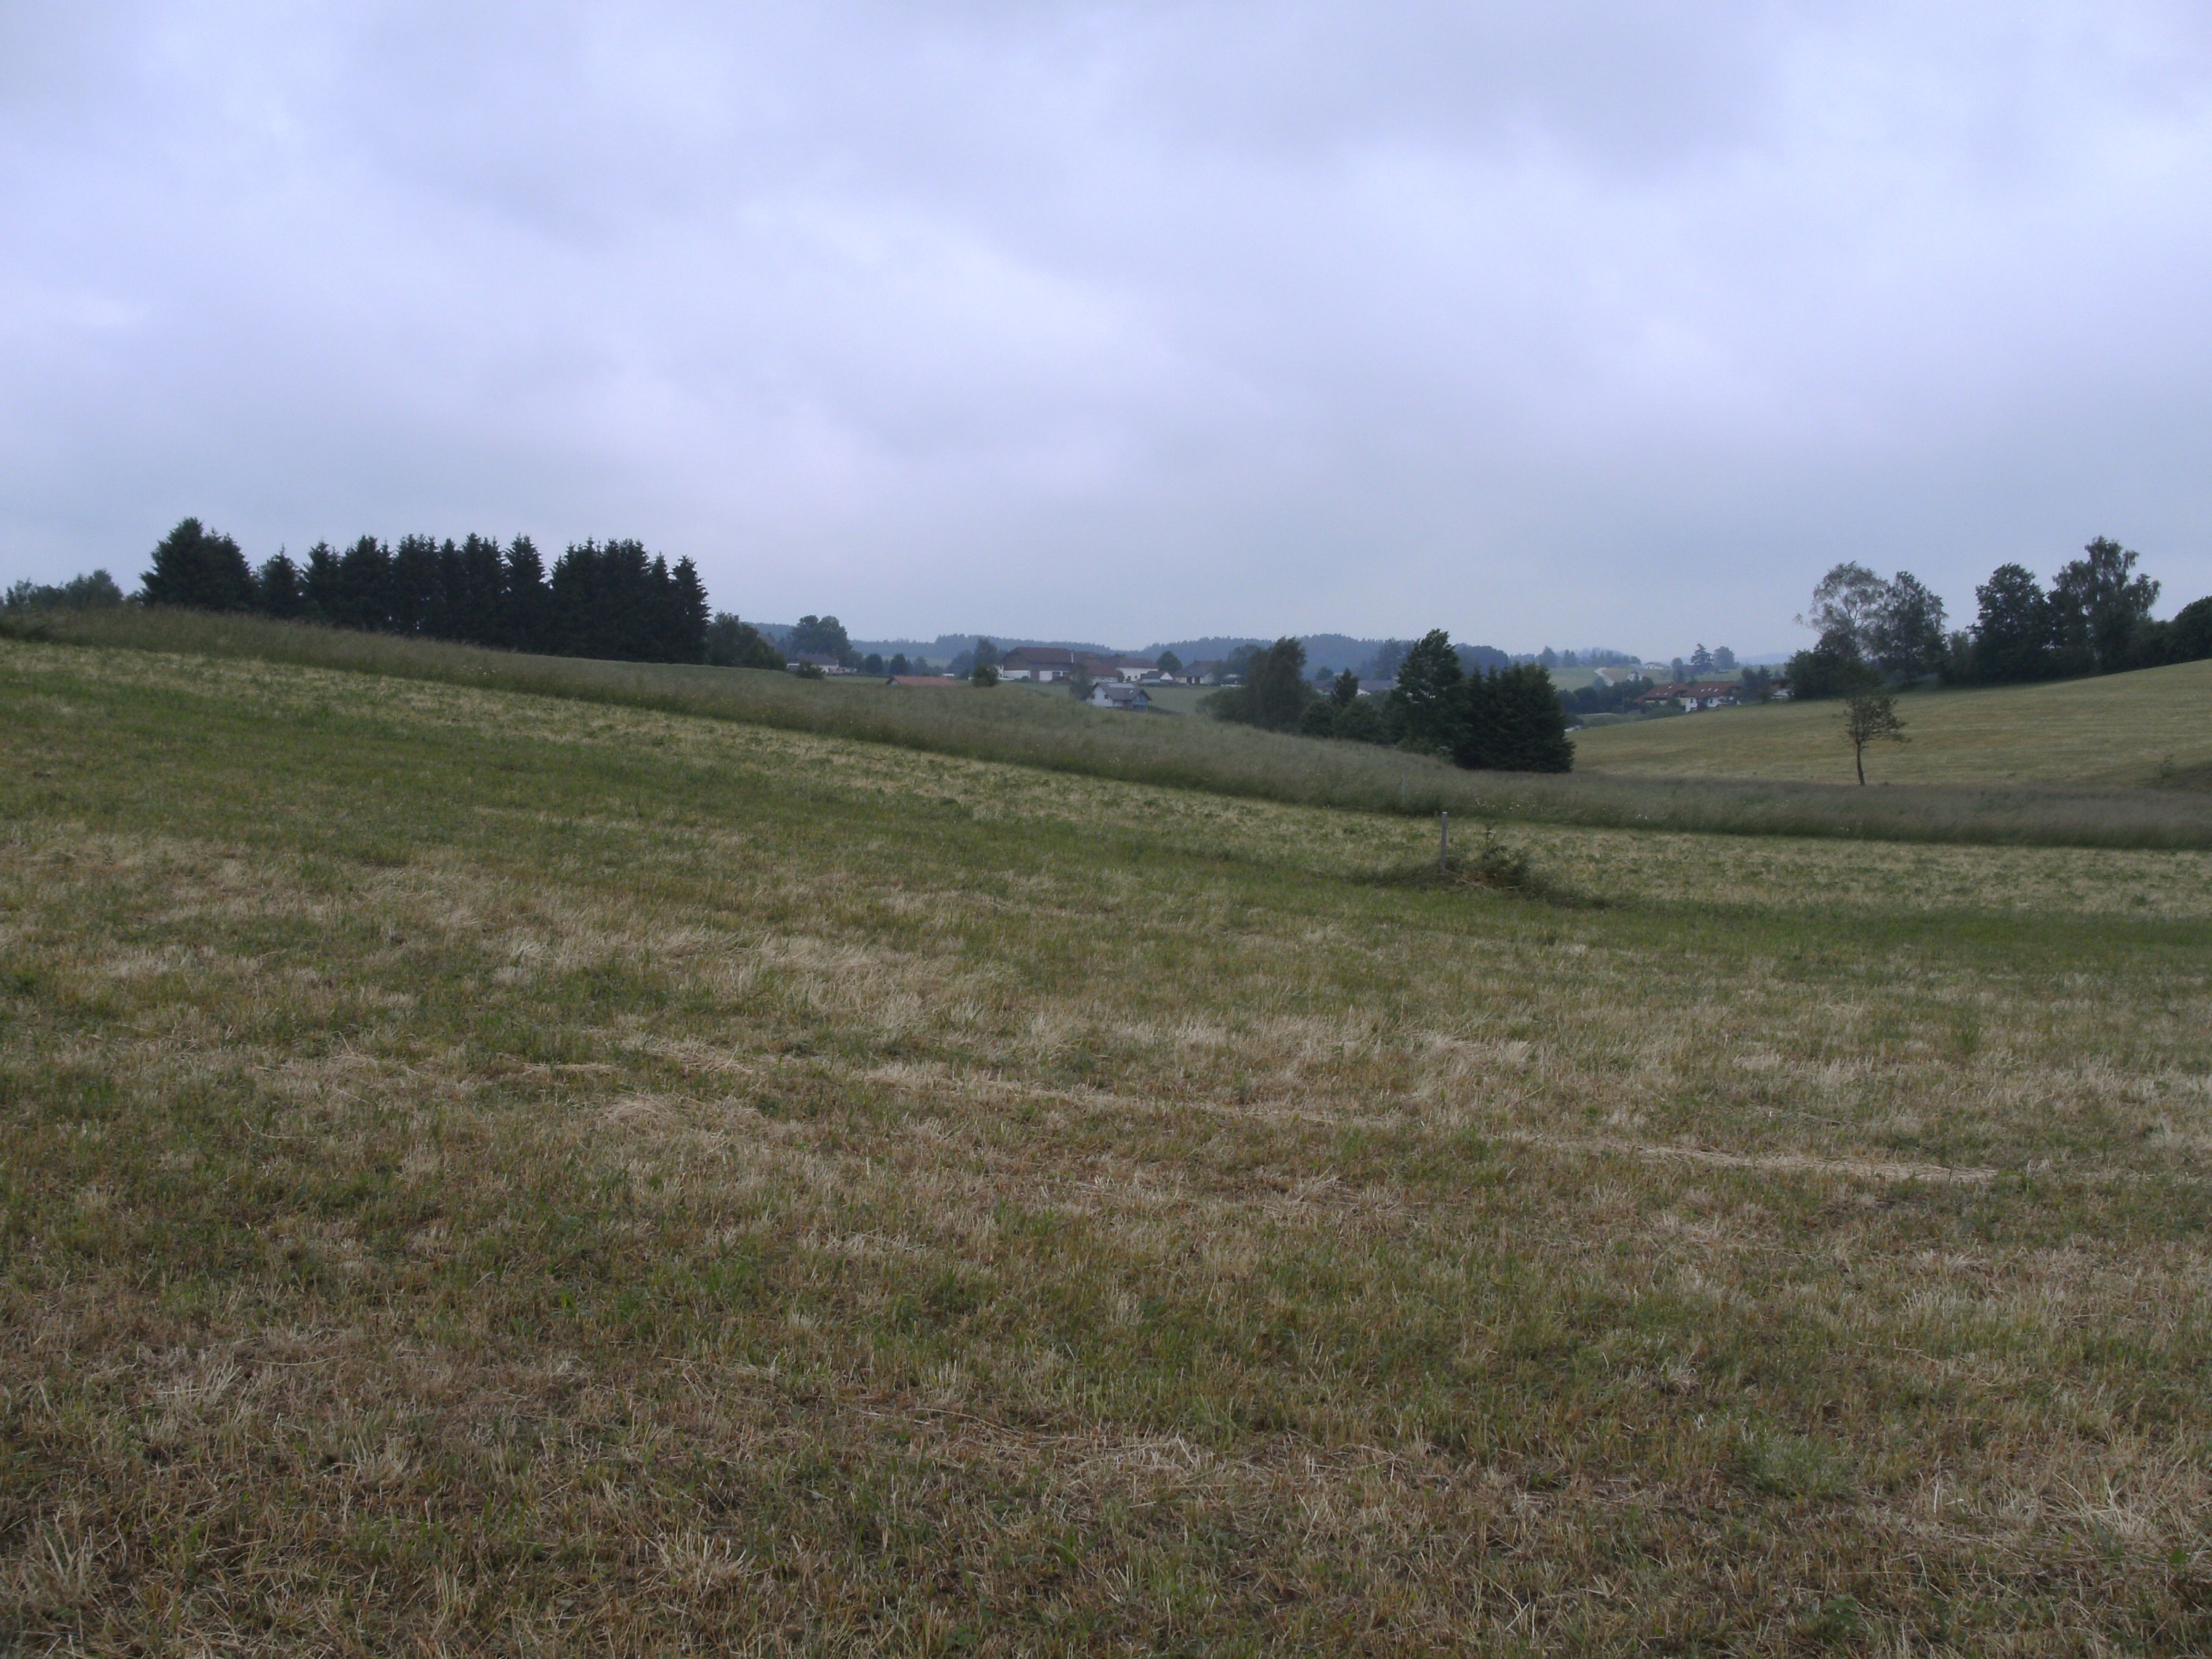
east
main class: Grassland
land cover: Grassland without tree/shrub cover
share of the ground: > 75 %
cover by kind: herbaceous plants 100 %
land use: Agriculture (excluding fallow land and kitchen gardens)
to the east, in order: Grassland without tree/shrub cover; Temporary grasslands
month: June
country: AT
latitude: 48.5004
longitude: 14.2906
